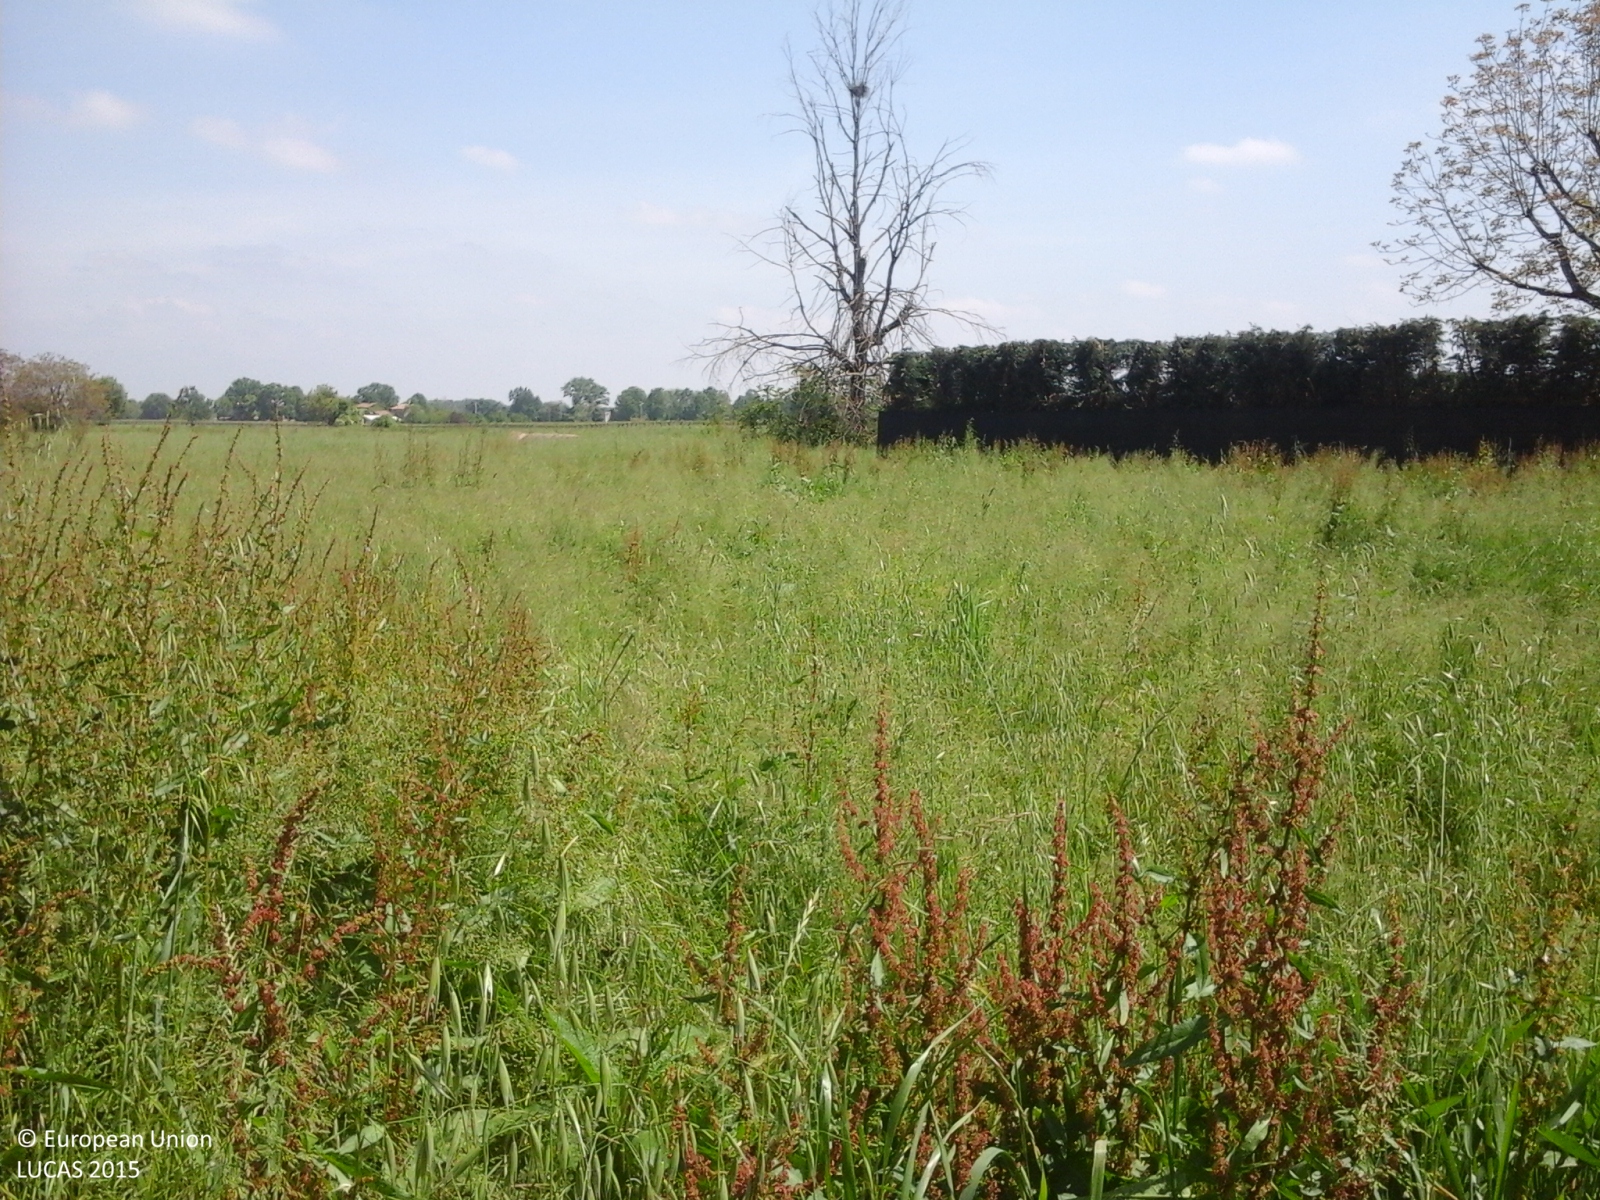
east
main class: Grassland
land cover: Spontaneously vegetated surfaces
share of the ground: > 75 %
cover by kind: herbaceous plants 100 %
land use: Agriculture (excluding fallow land and kitchen gardens)
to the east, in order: Spontaneously vegetated surfaces; Electric lines; Spontaneously vegetated surfaces; Managed hedges; Grassland without tree/shrub cover; Managed hedges; Spontaneously vegetated surfaces; Tracks; Spontaneously vegetated surfaces; Maize
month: May
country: IT
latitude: 44.5634
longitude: 10.8669
